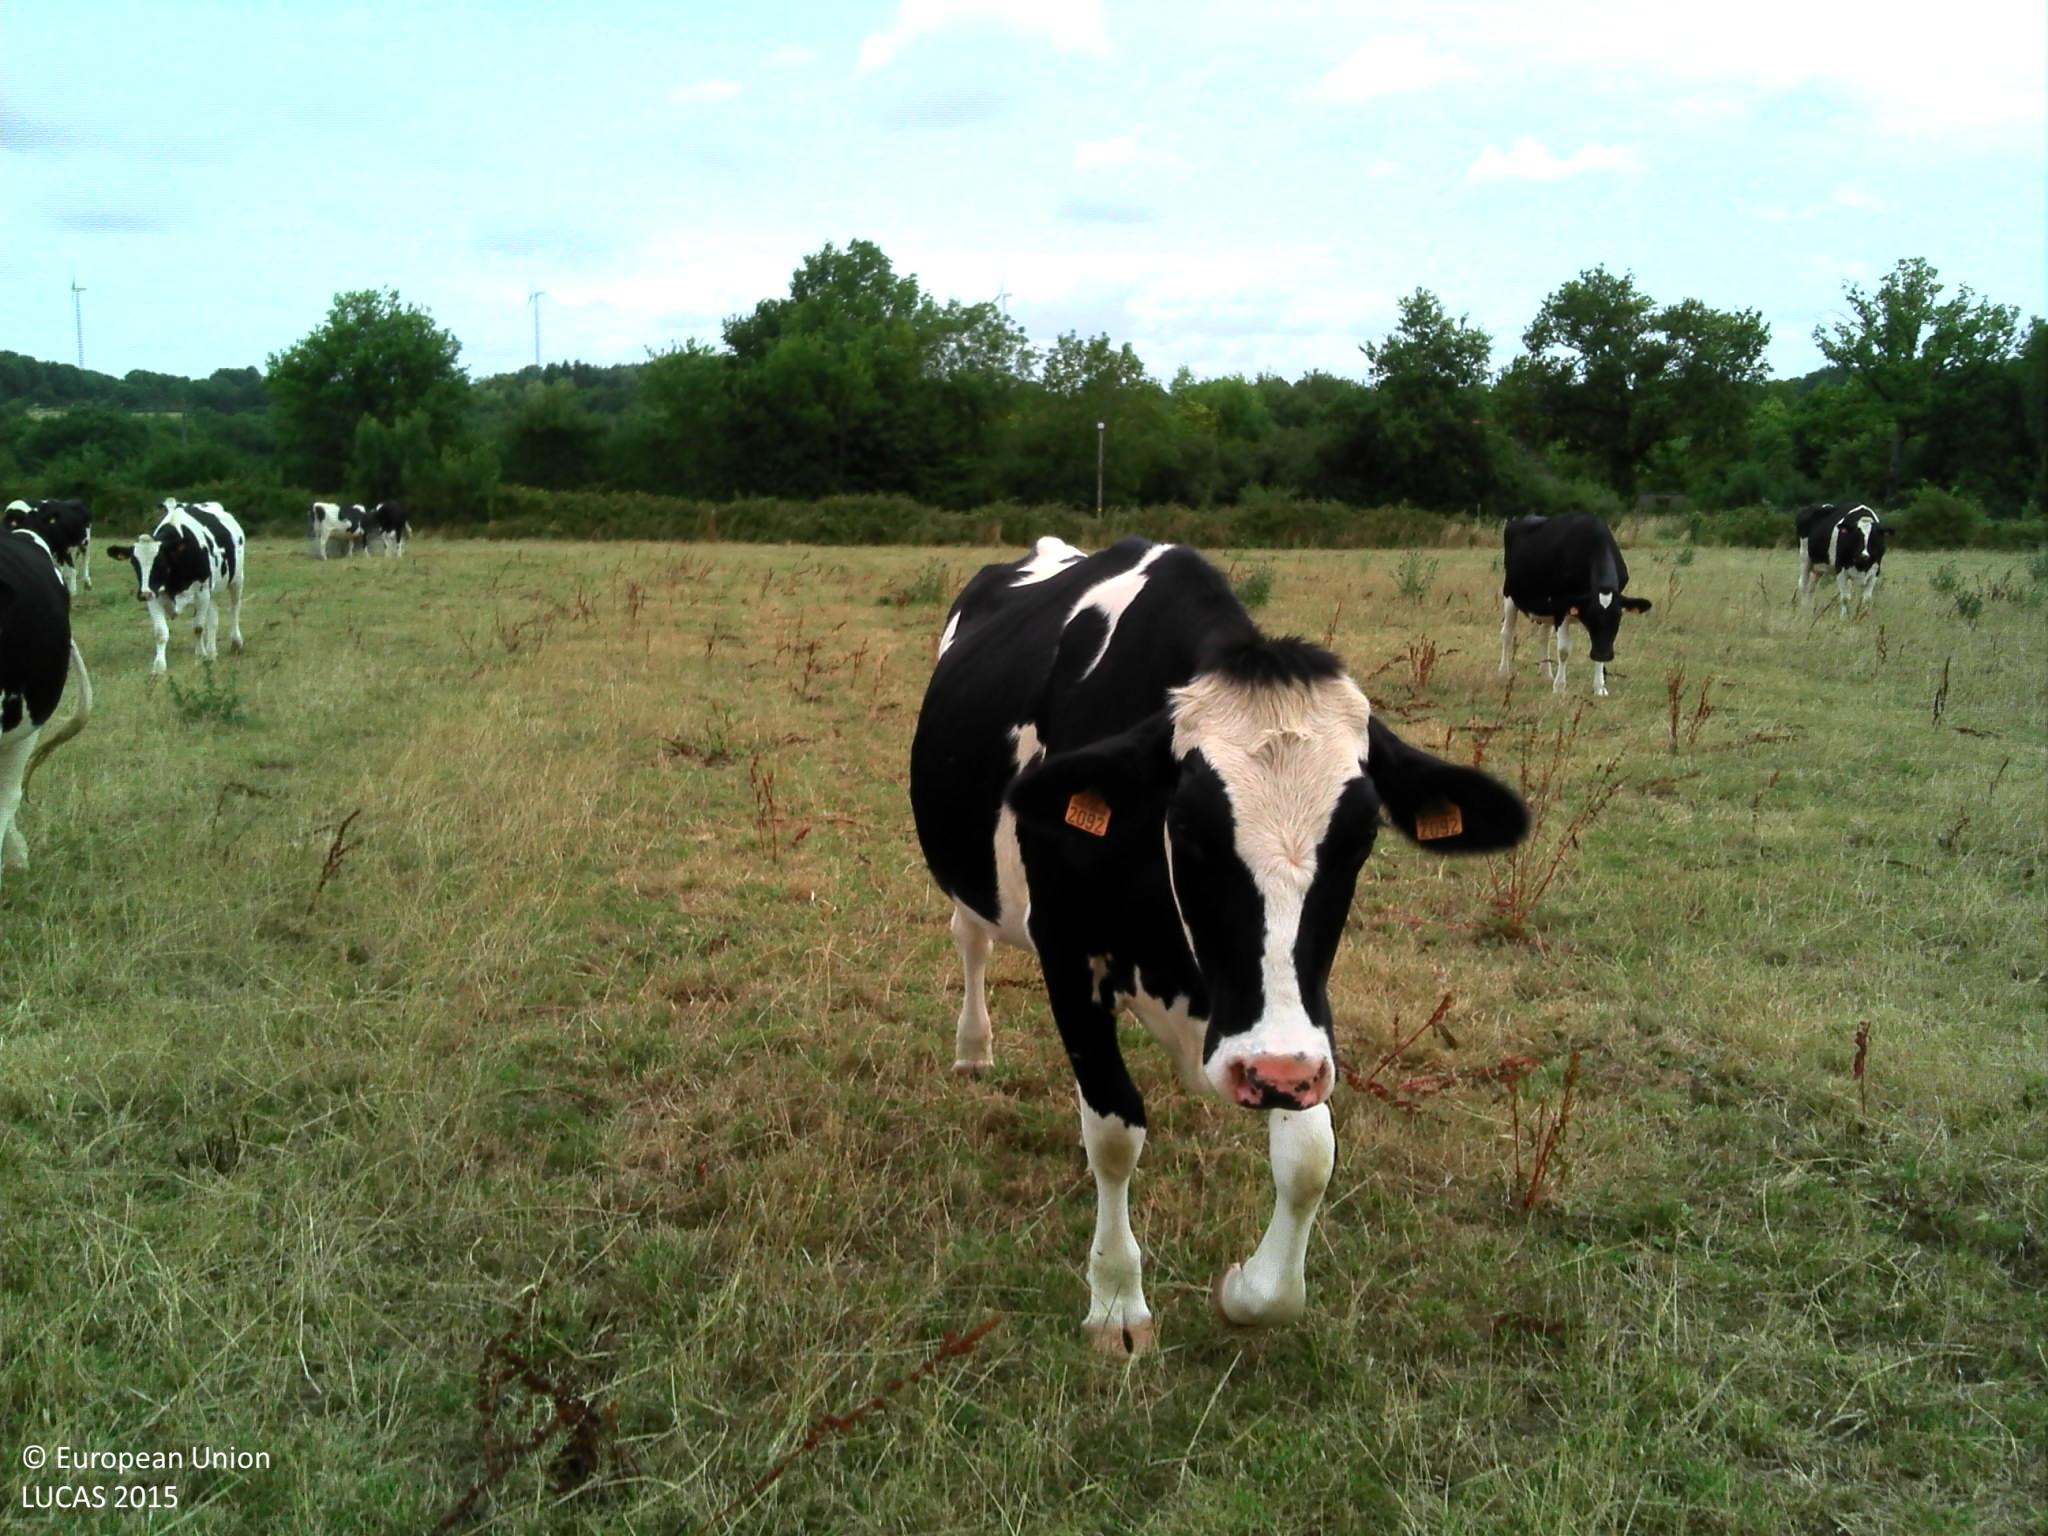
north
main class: Cropland
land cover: Temporary grasslands
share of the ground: > 75 %
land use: Agriculture (excluding fallow land and kitchen gardens)
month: July
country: FR
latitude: 47.7233
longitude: -1.5497
